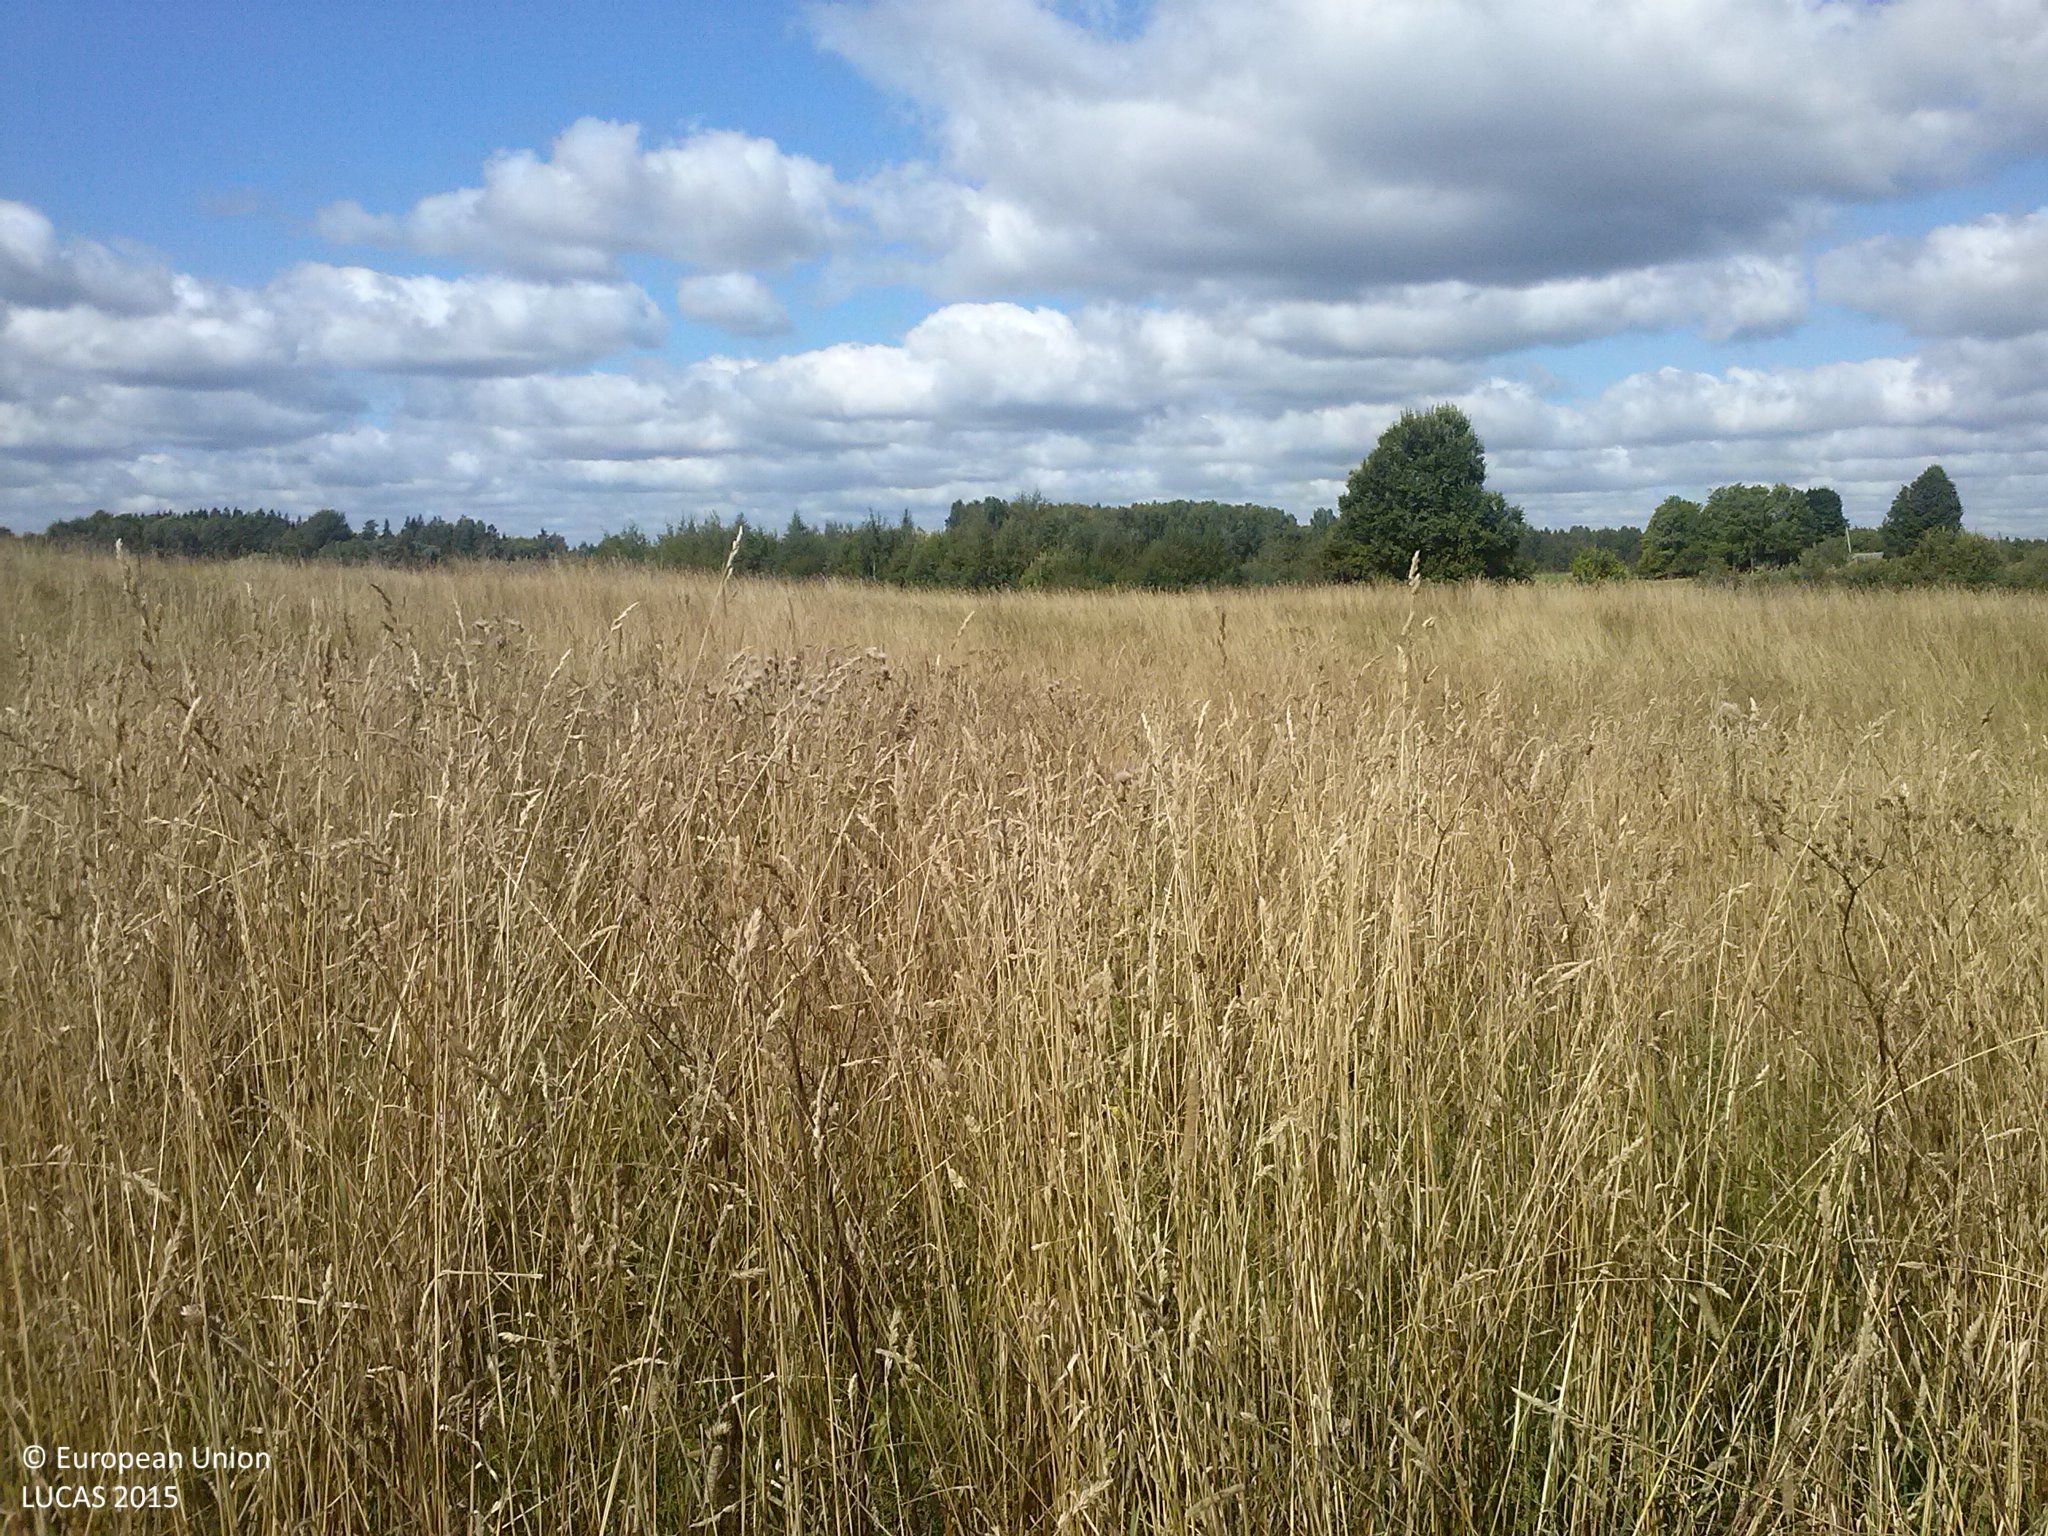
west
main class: Grassland
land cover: Grassland without tree/shrub cover
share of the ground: > 75 %
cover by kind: herbaceous plants 100 %
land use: Agriculture (excluding fallow land and kitchen gardens)
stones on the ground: < 10 %
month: August
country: LV
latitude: 56.1344
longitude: 26.8129
